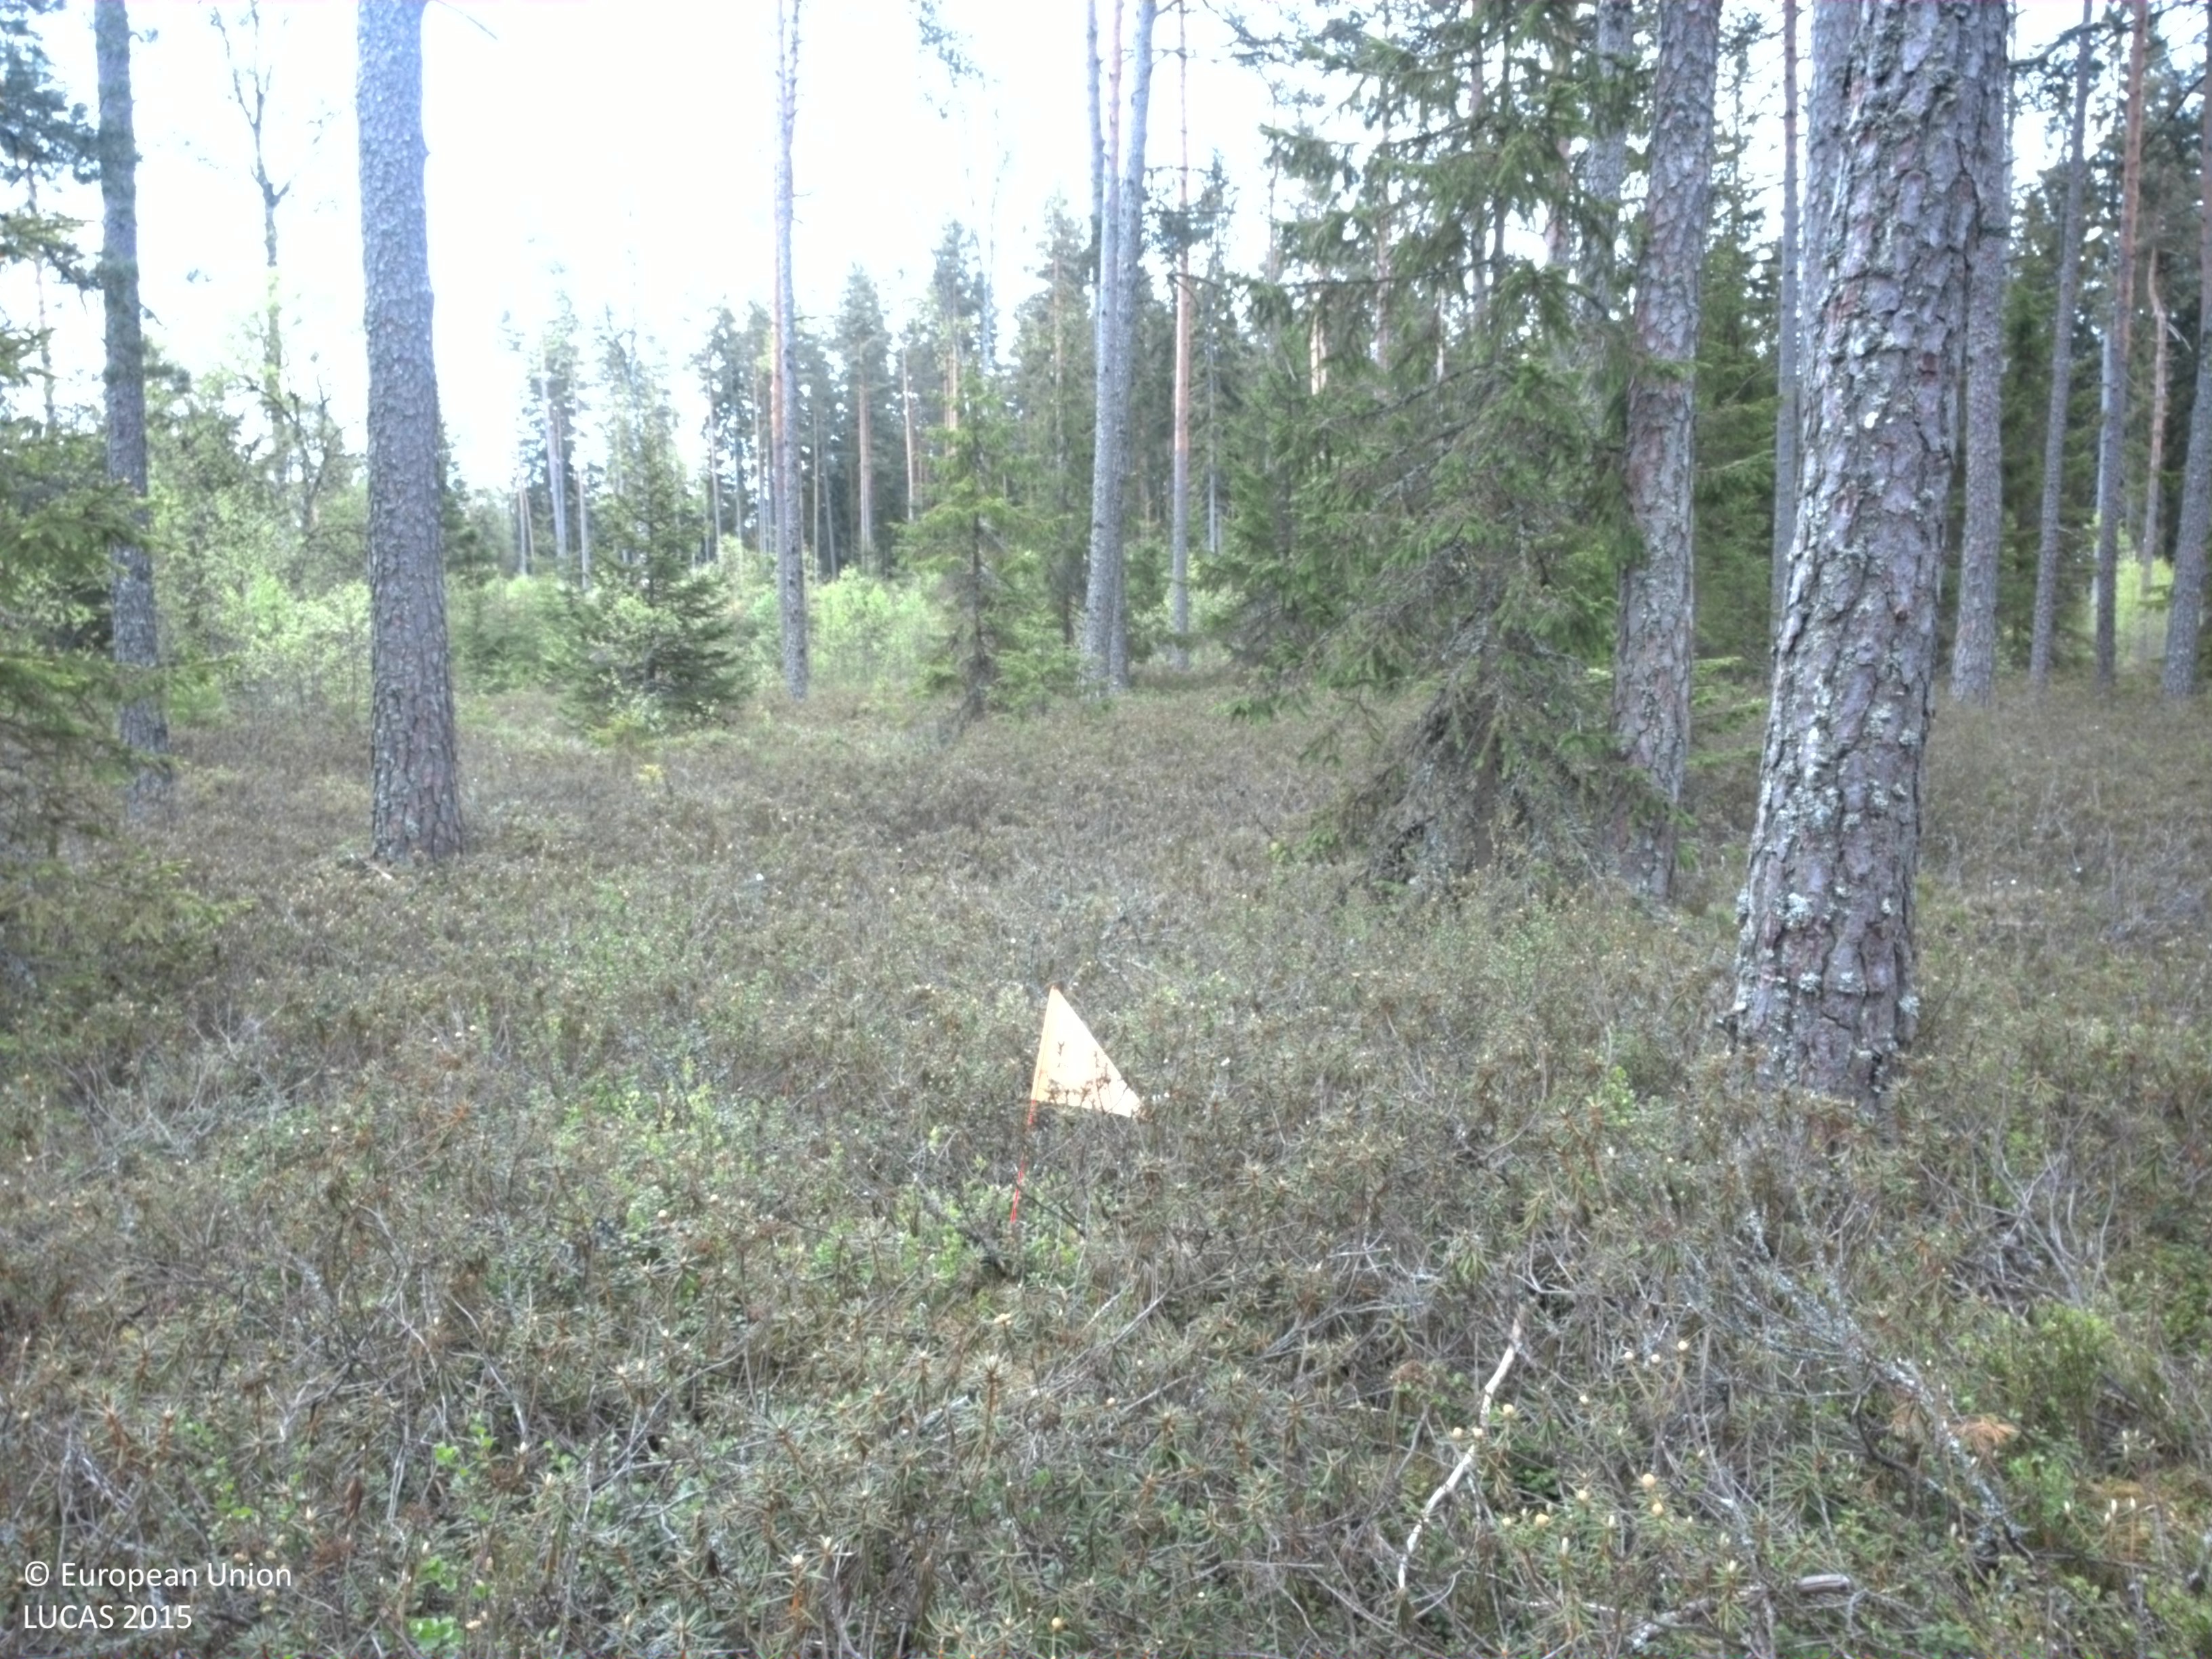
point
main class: Woodland
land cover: Pine dominated coniferous woodland
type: boreal forest
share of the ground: 50 - 75 %
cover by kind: coniferous forest trees 50 %, shrubs 25 %, lichens and mosses 20 %, broadleaved forest trees 5 %
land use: Forestry
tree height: > 5 m
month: May
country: SE
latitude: 56.9688
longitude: 15.1130
